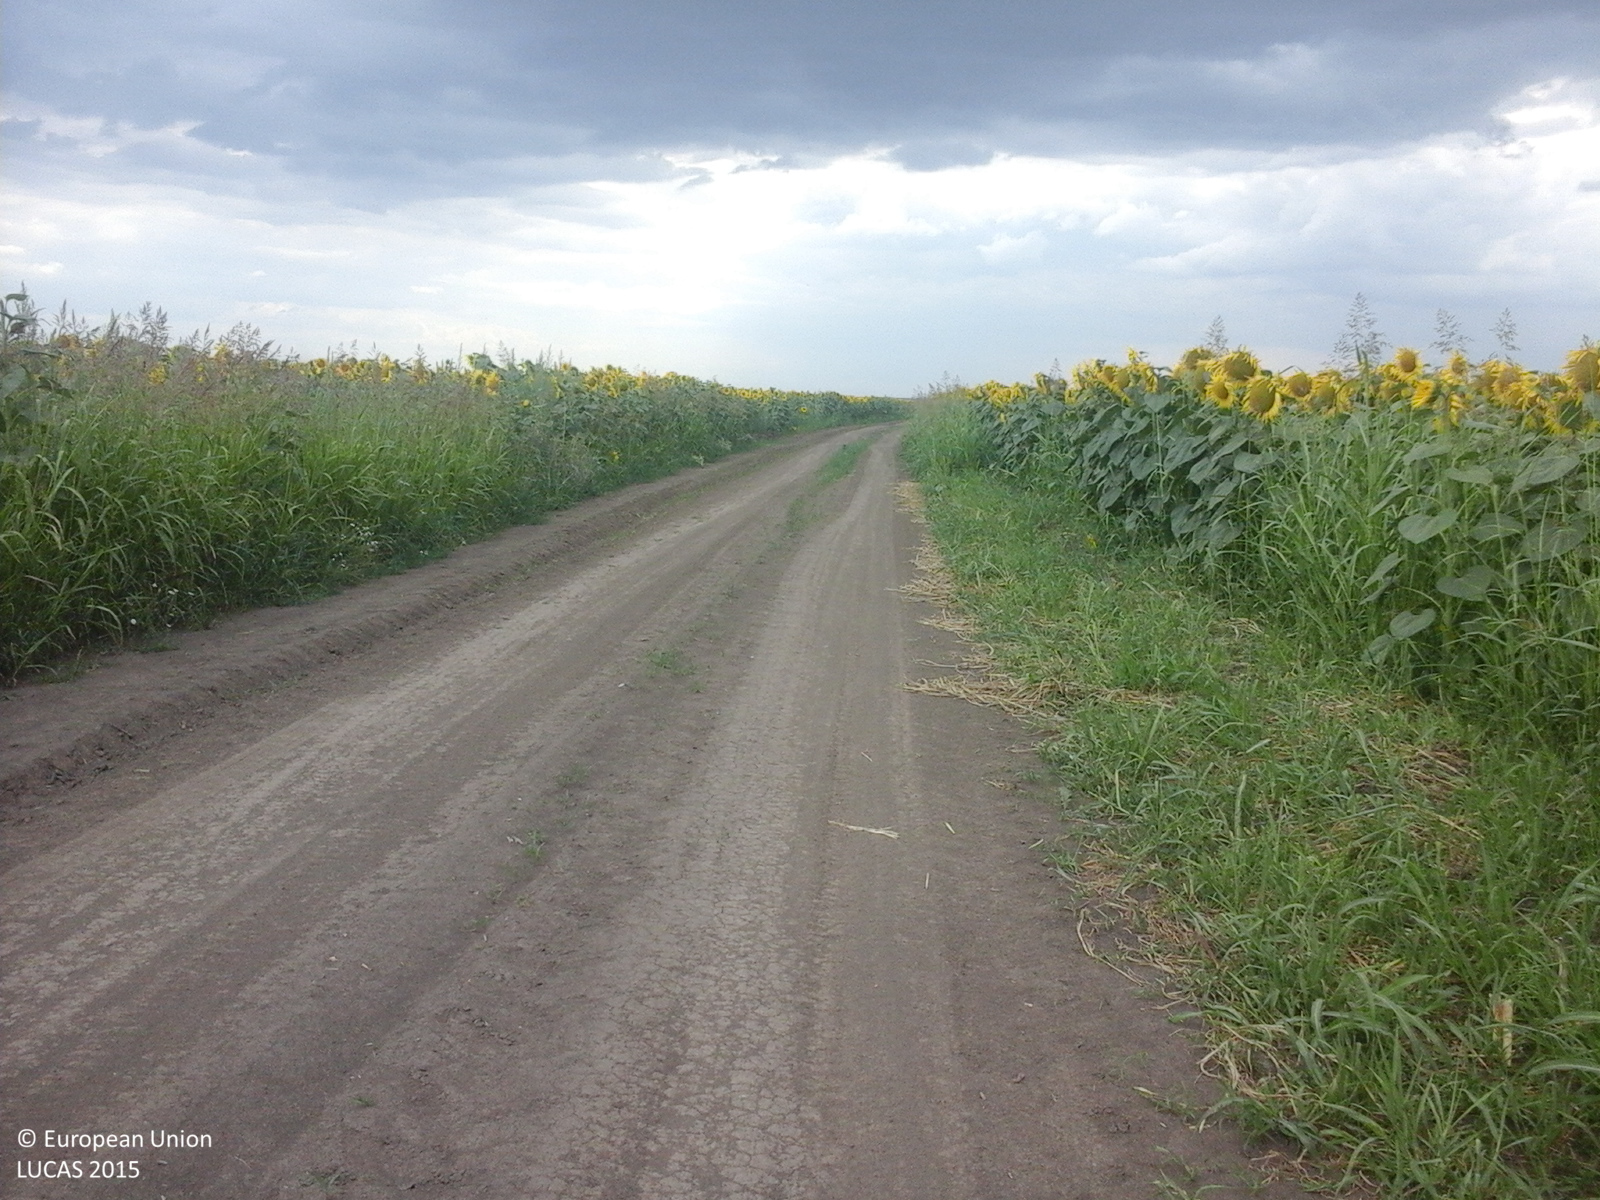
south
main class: Cropland
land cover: Sunflower
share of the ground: > 75 %
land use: Agriculture (excluding fallow land and kitchen gardens)
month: July
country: RO
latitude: 43.8012
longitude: 25.2559
